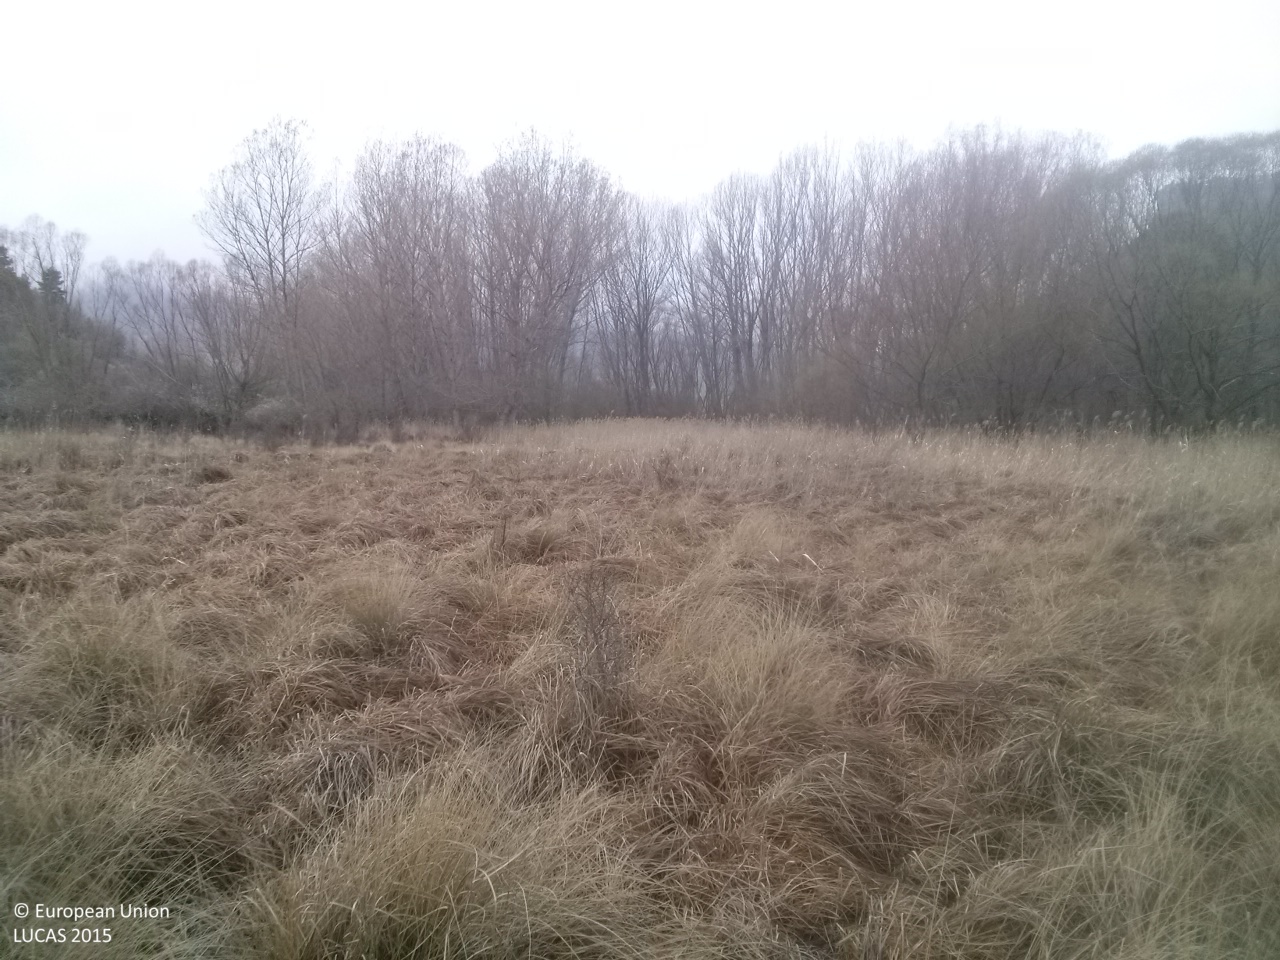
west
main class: Shrubland
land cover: Shrubland without tree cover
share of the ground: 25 - 50 %
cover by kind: herbaceous plants 65 %, shrubs 35 %
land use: Semi-natural and natural areas not in use
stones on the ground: < 10 %
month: April
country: ES
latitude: 40.2261
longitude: -1.9680
